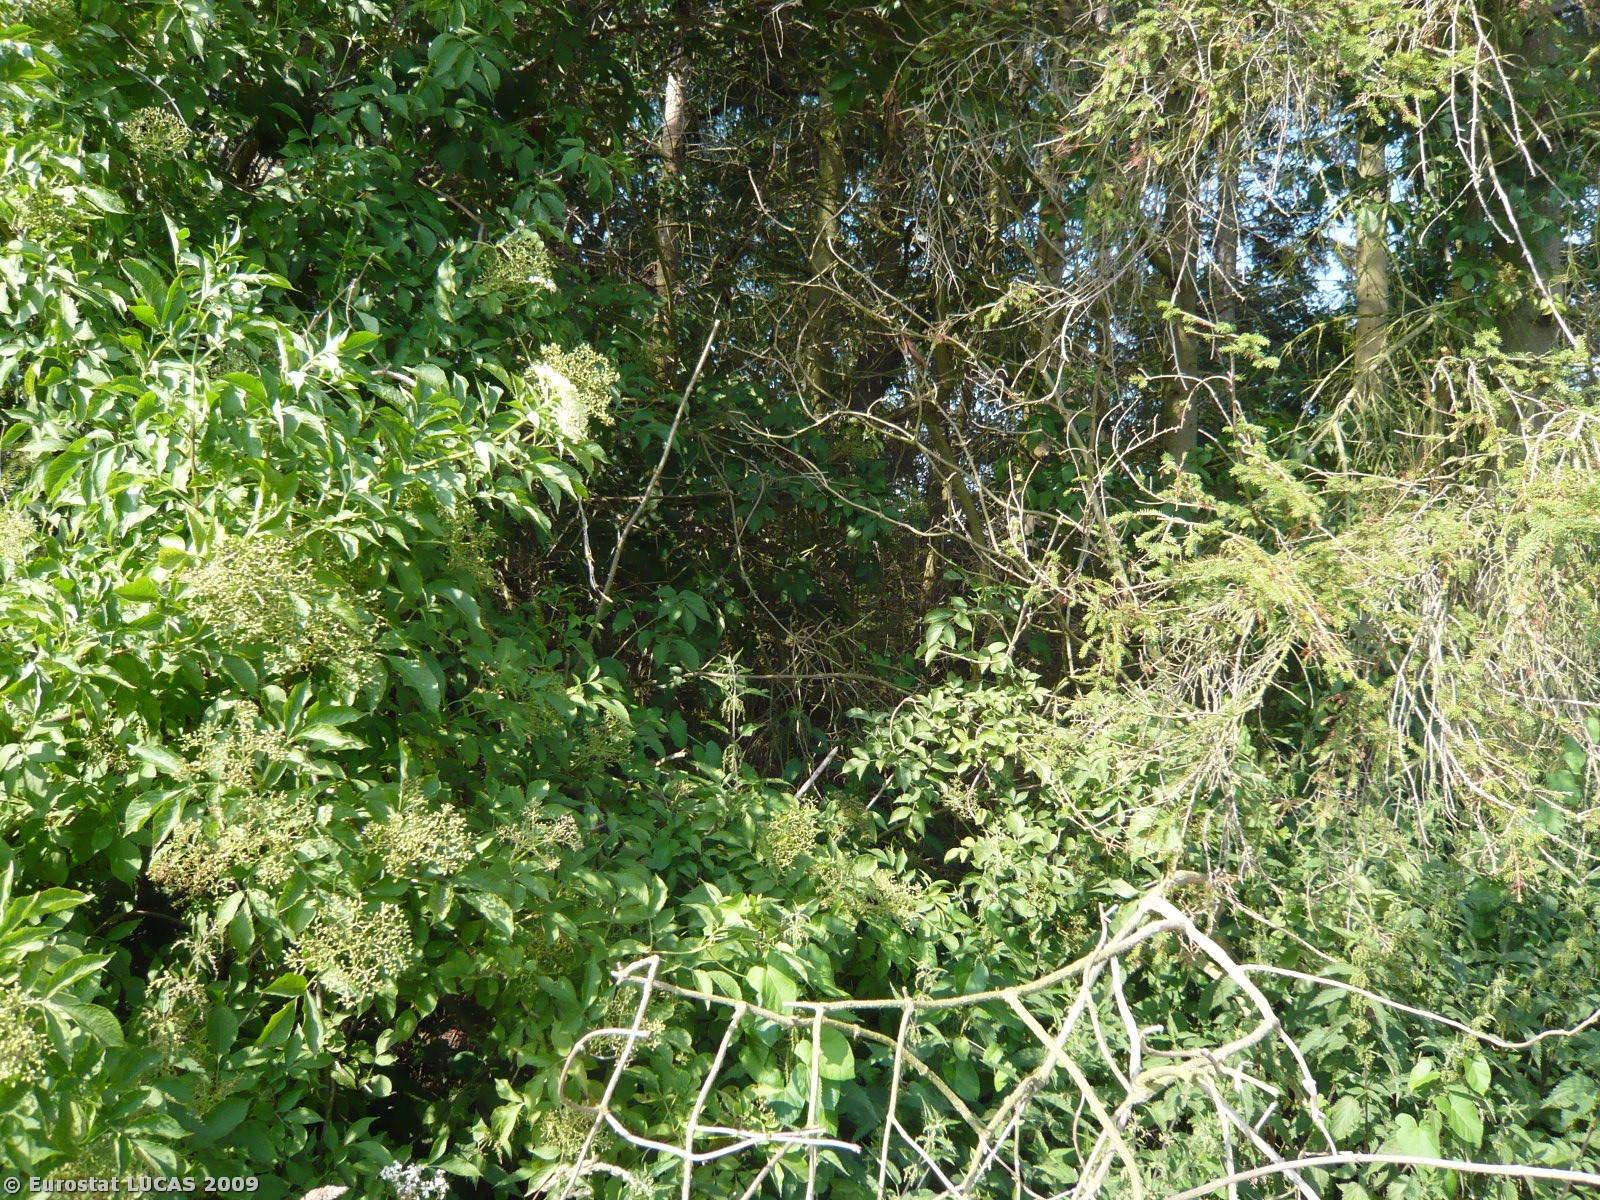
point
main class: Woodland
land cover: Coniferous woodland
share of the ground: > 75 %
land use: Unused
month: July
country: DK
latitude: 55.6358
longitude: 11.7935
